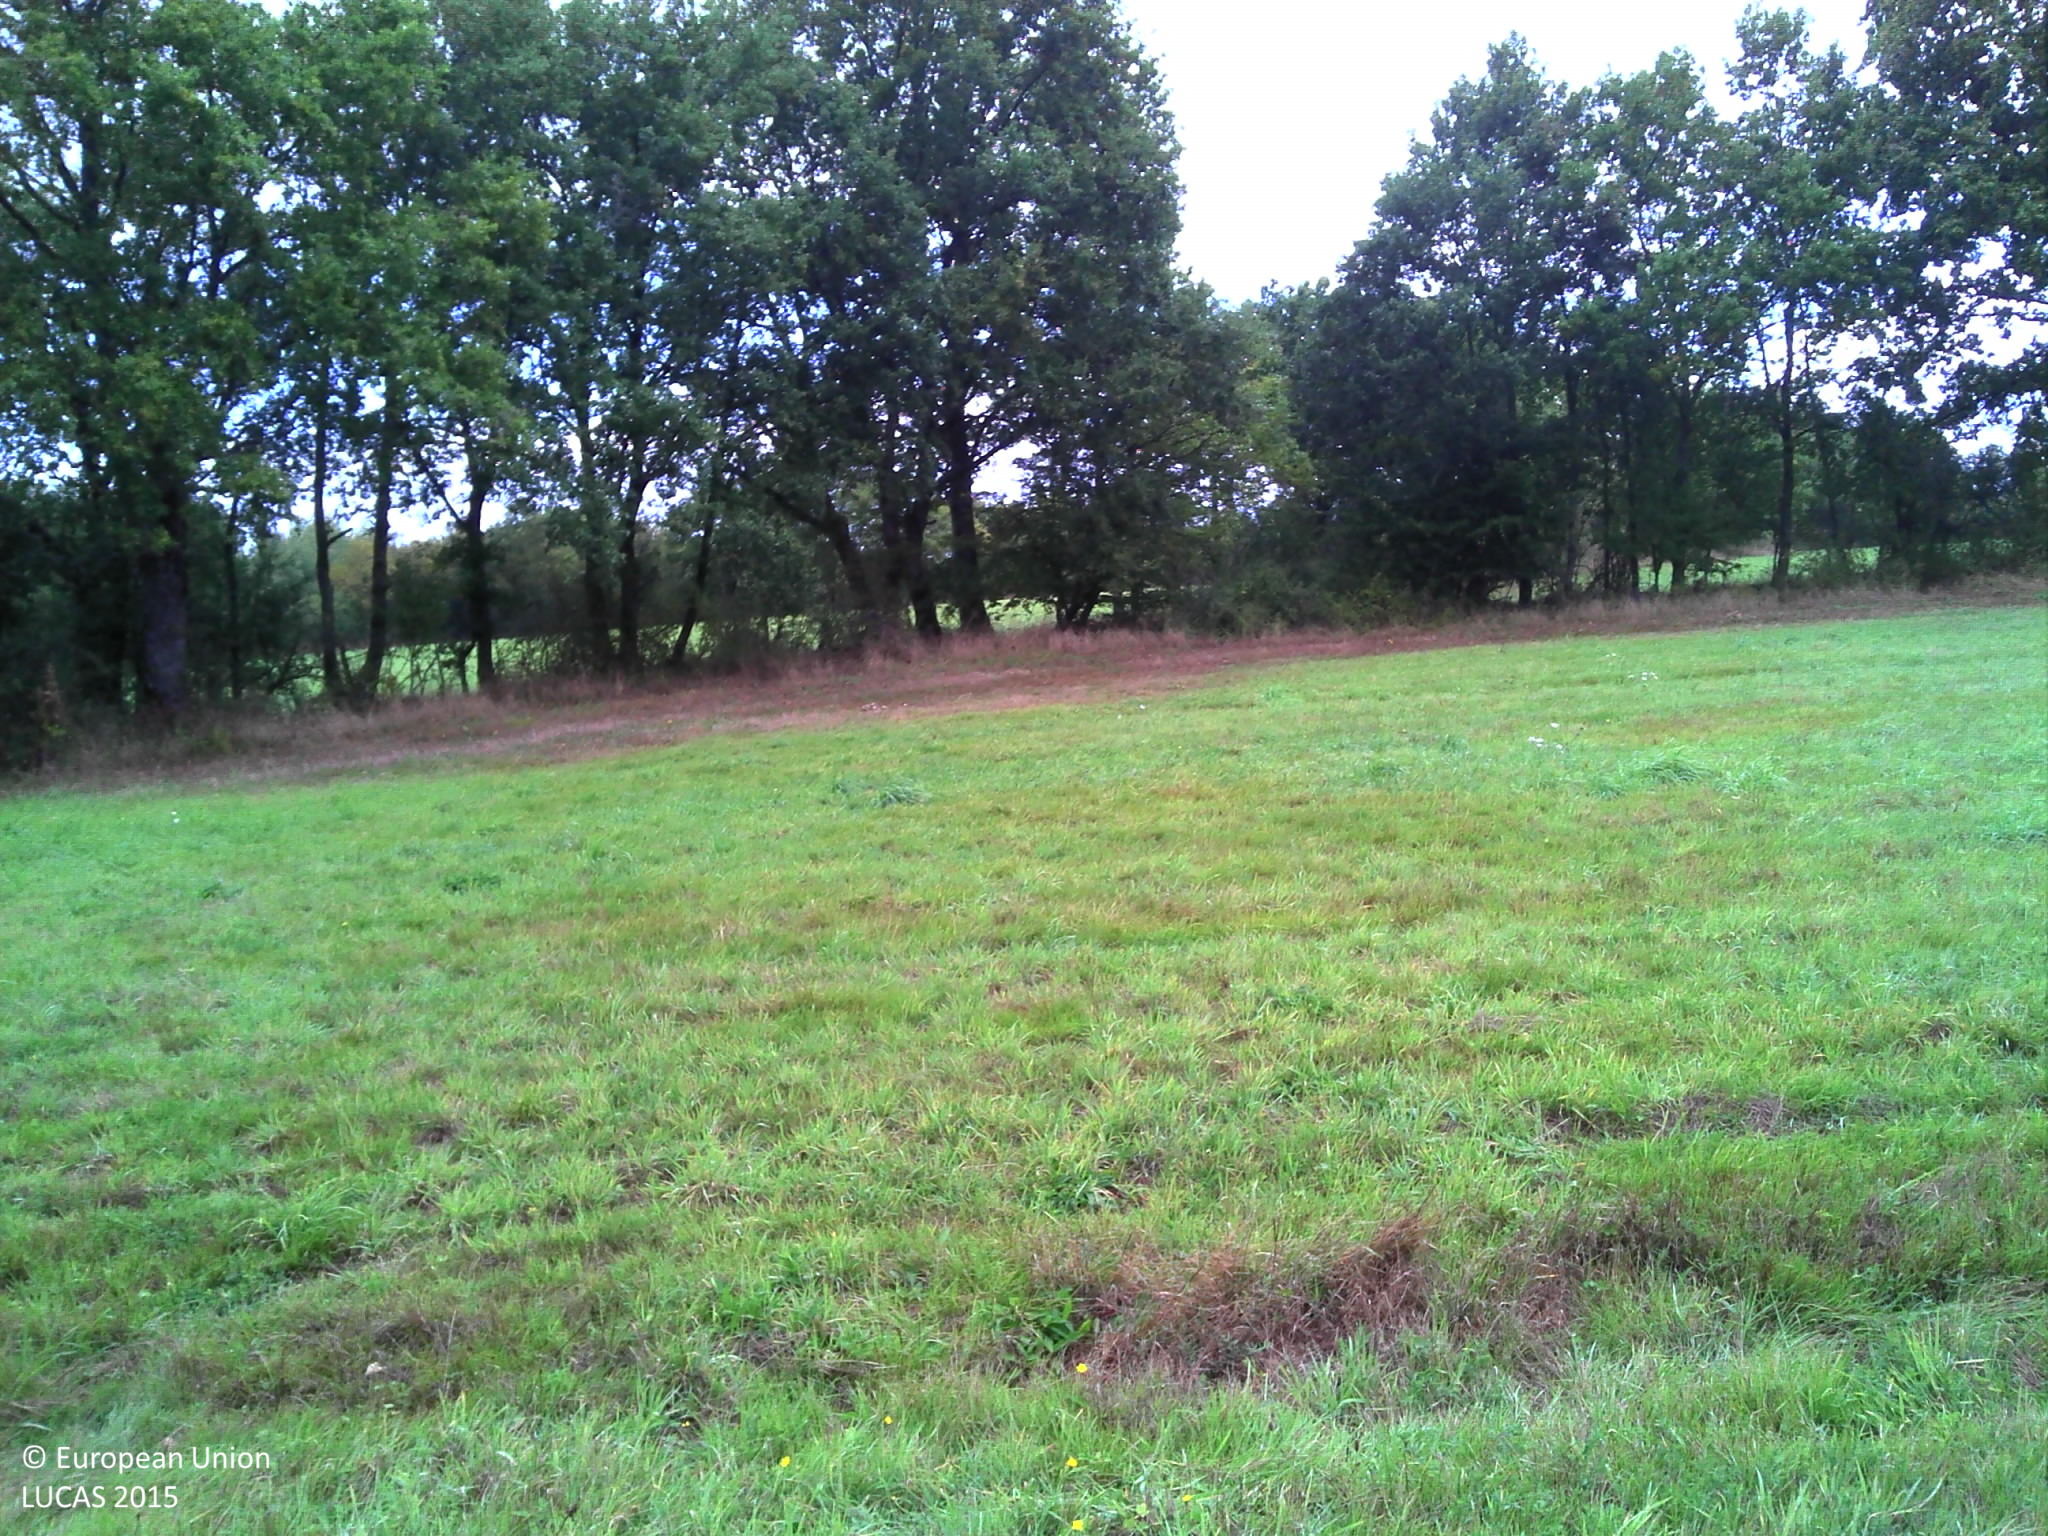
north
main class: Grassland
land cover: Grassland without tree/shrub cover
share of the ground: > 75 %
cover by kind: herbaceous plants 100 %
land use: Agriculture (excluding fallow land and kitchen gardens)
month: September
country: FR
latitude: 46.6412
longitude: 1.6684
